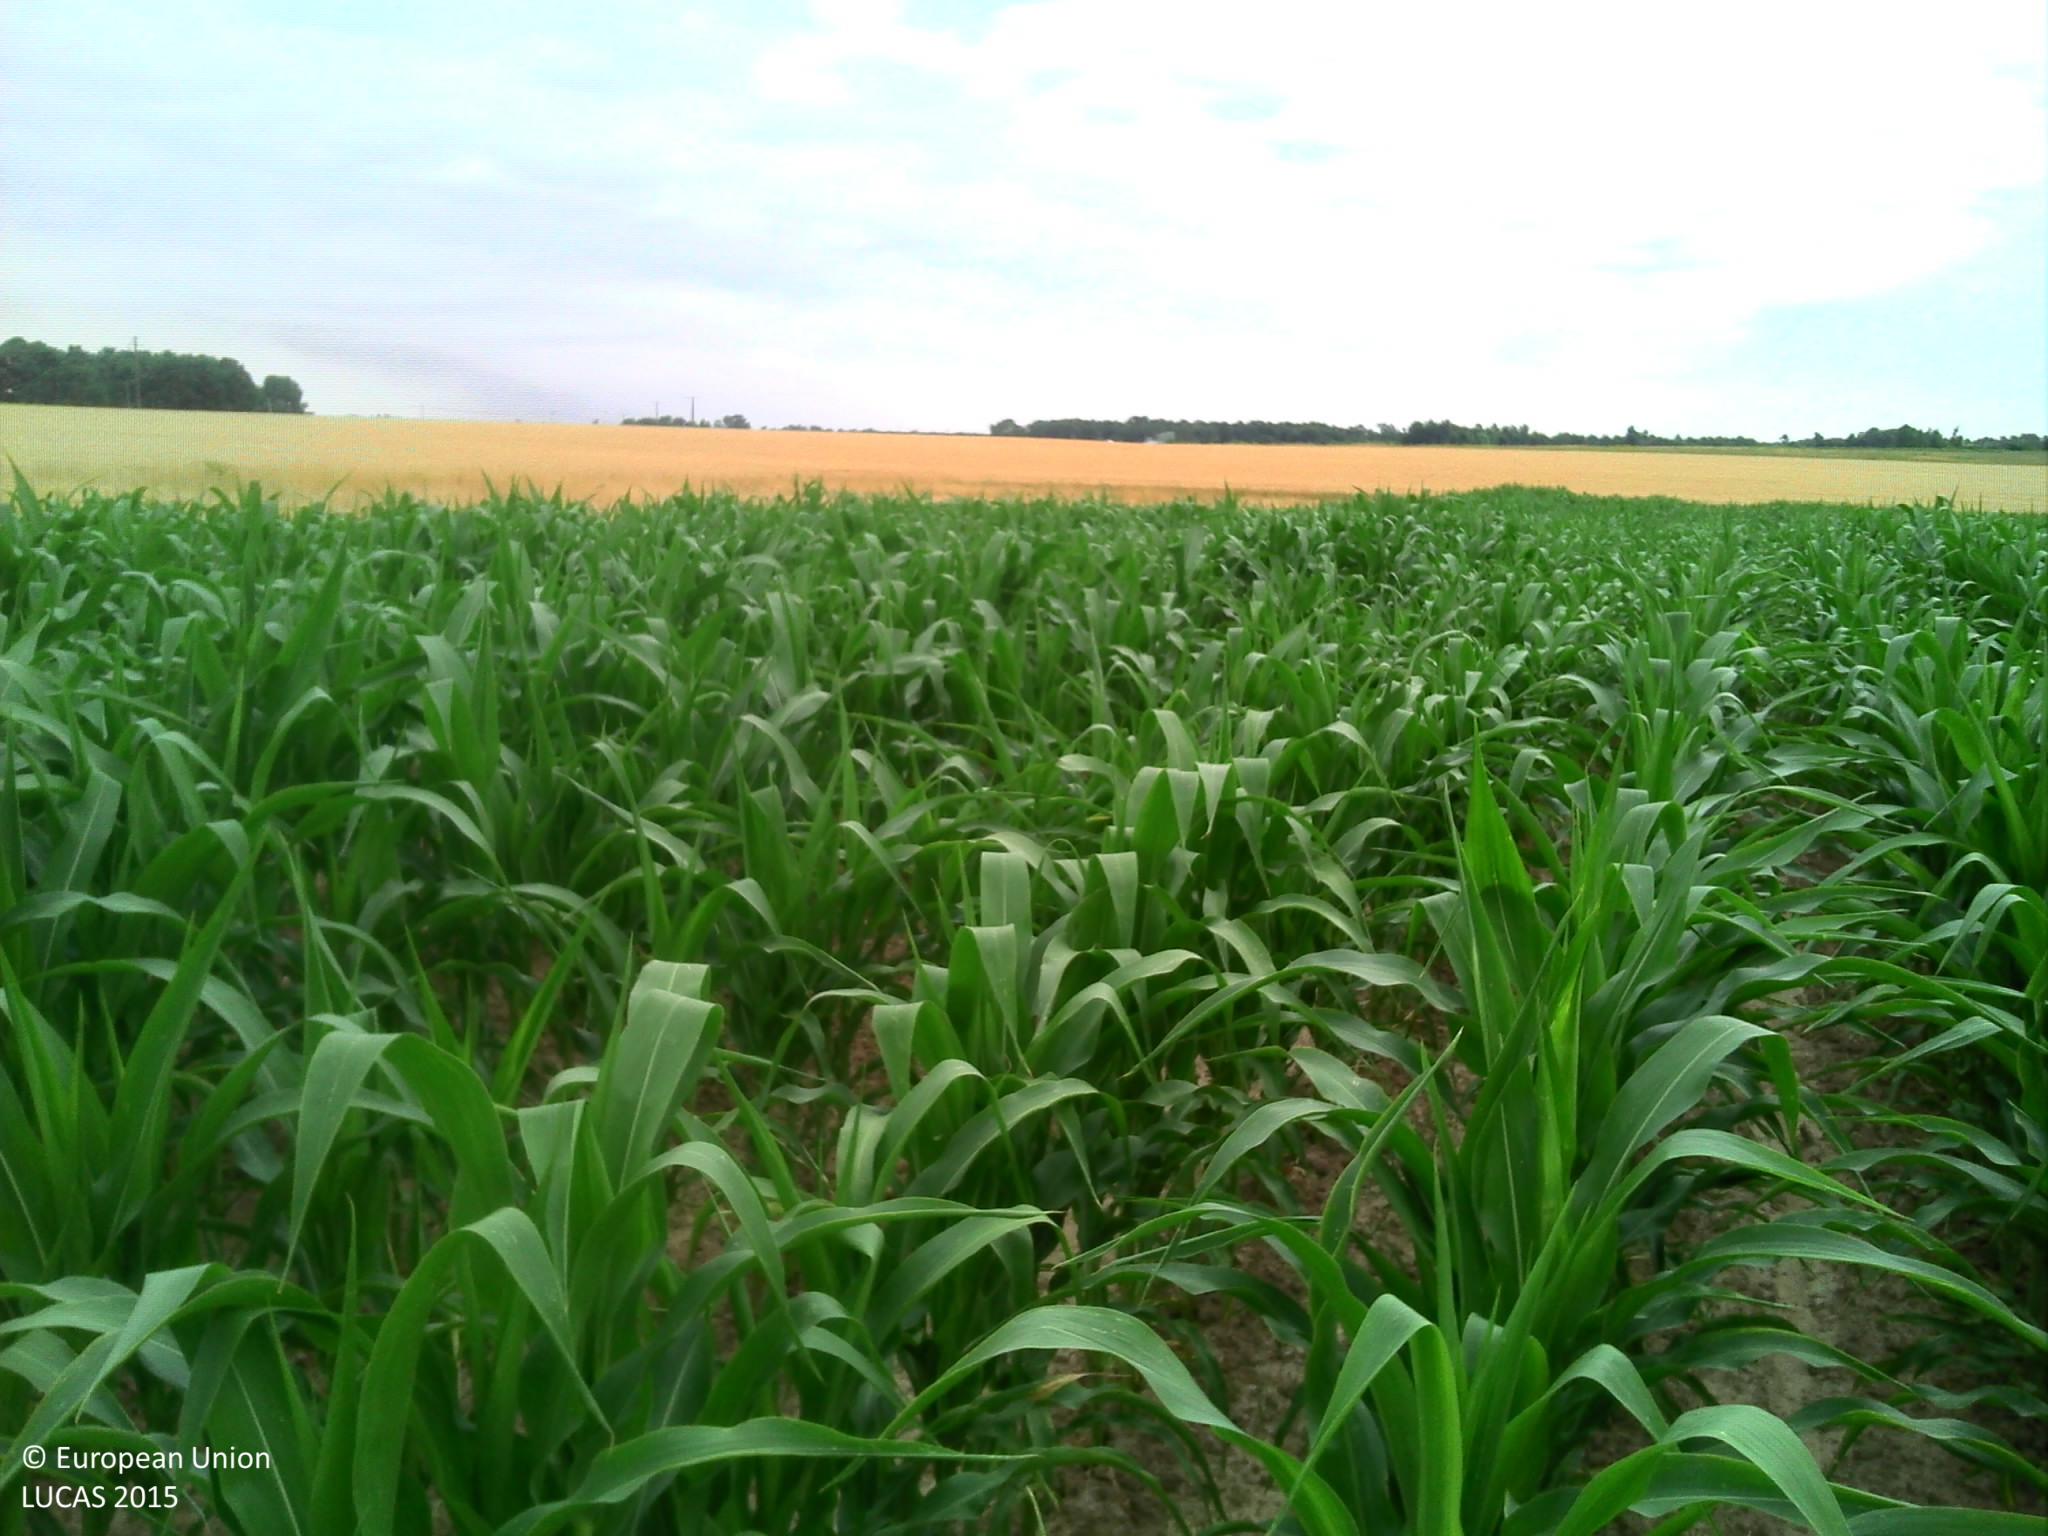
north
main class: Cropland
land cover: Maize
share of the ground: > 75 %
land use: Agriculture (excluding fallow land and kitchen gardens)
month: July
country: FR
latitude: 45.4243
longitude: -0.5915
